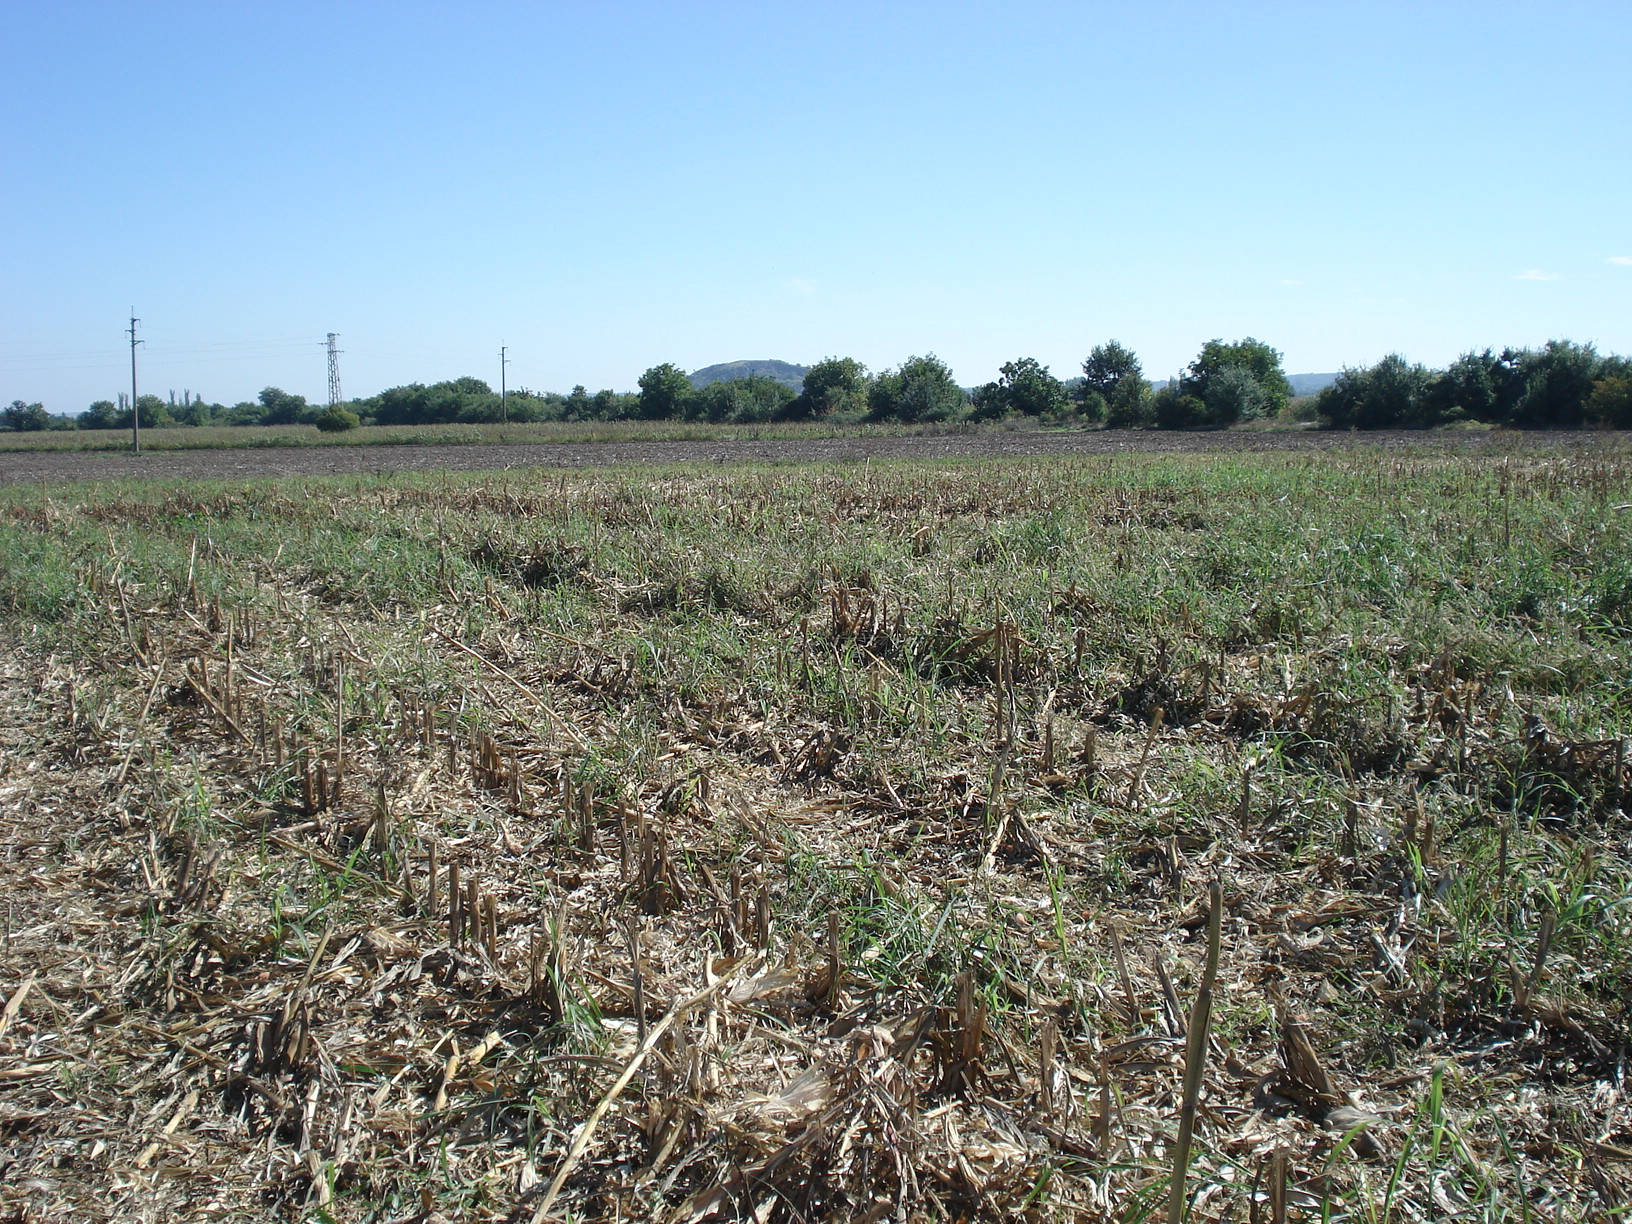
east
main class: Cropland
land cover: Maize
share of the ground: 50 - 75 %
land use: Agriculture (excluding fallow land and kitchen gardens)
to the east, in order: Maize; Grass margins; Other bare soil; Sunflower; Abandoned hedges; Ditches and canals; Abandoned hedges; Grass margins; Maize
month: September
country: BG
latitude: 43.2967
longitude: 25.1973
